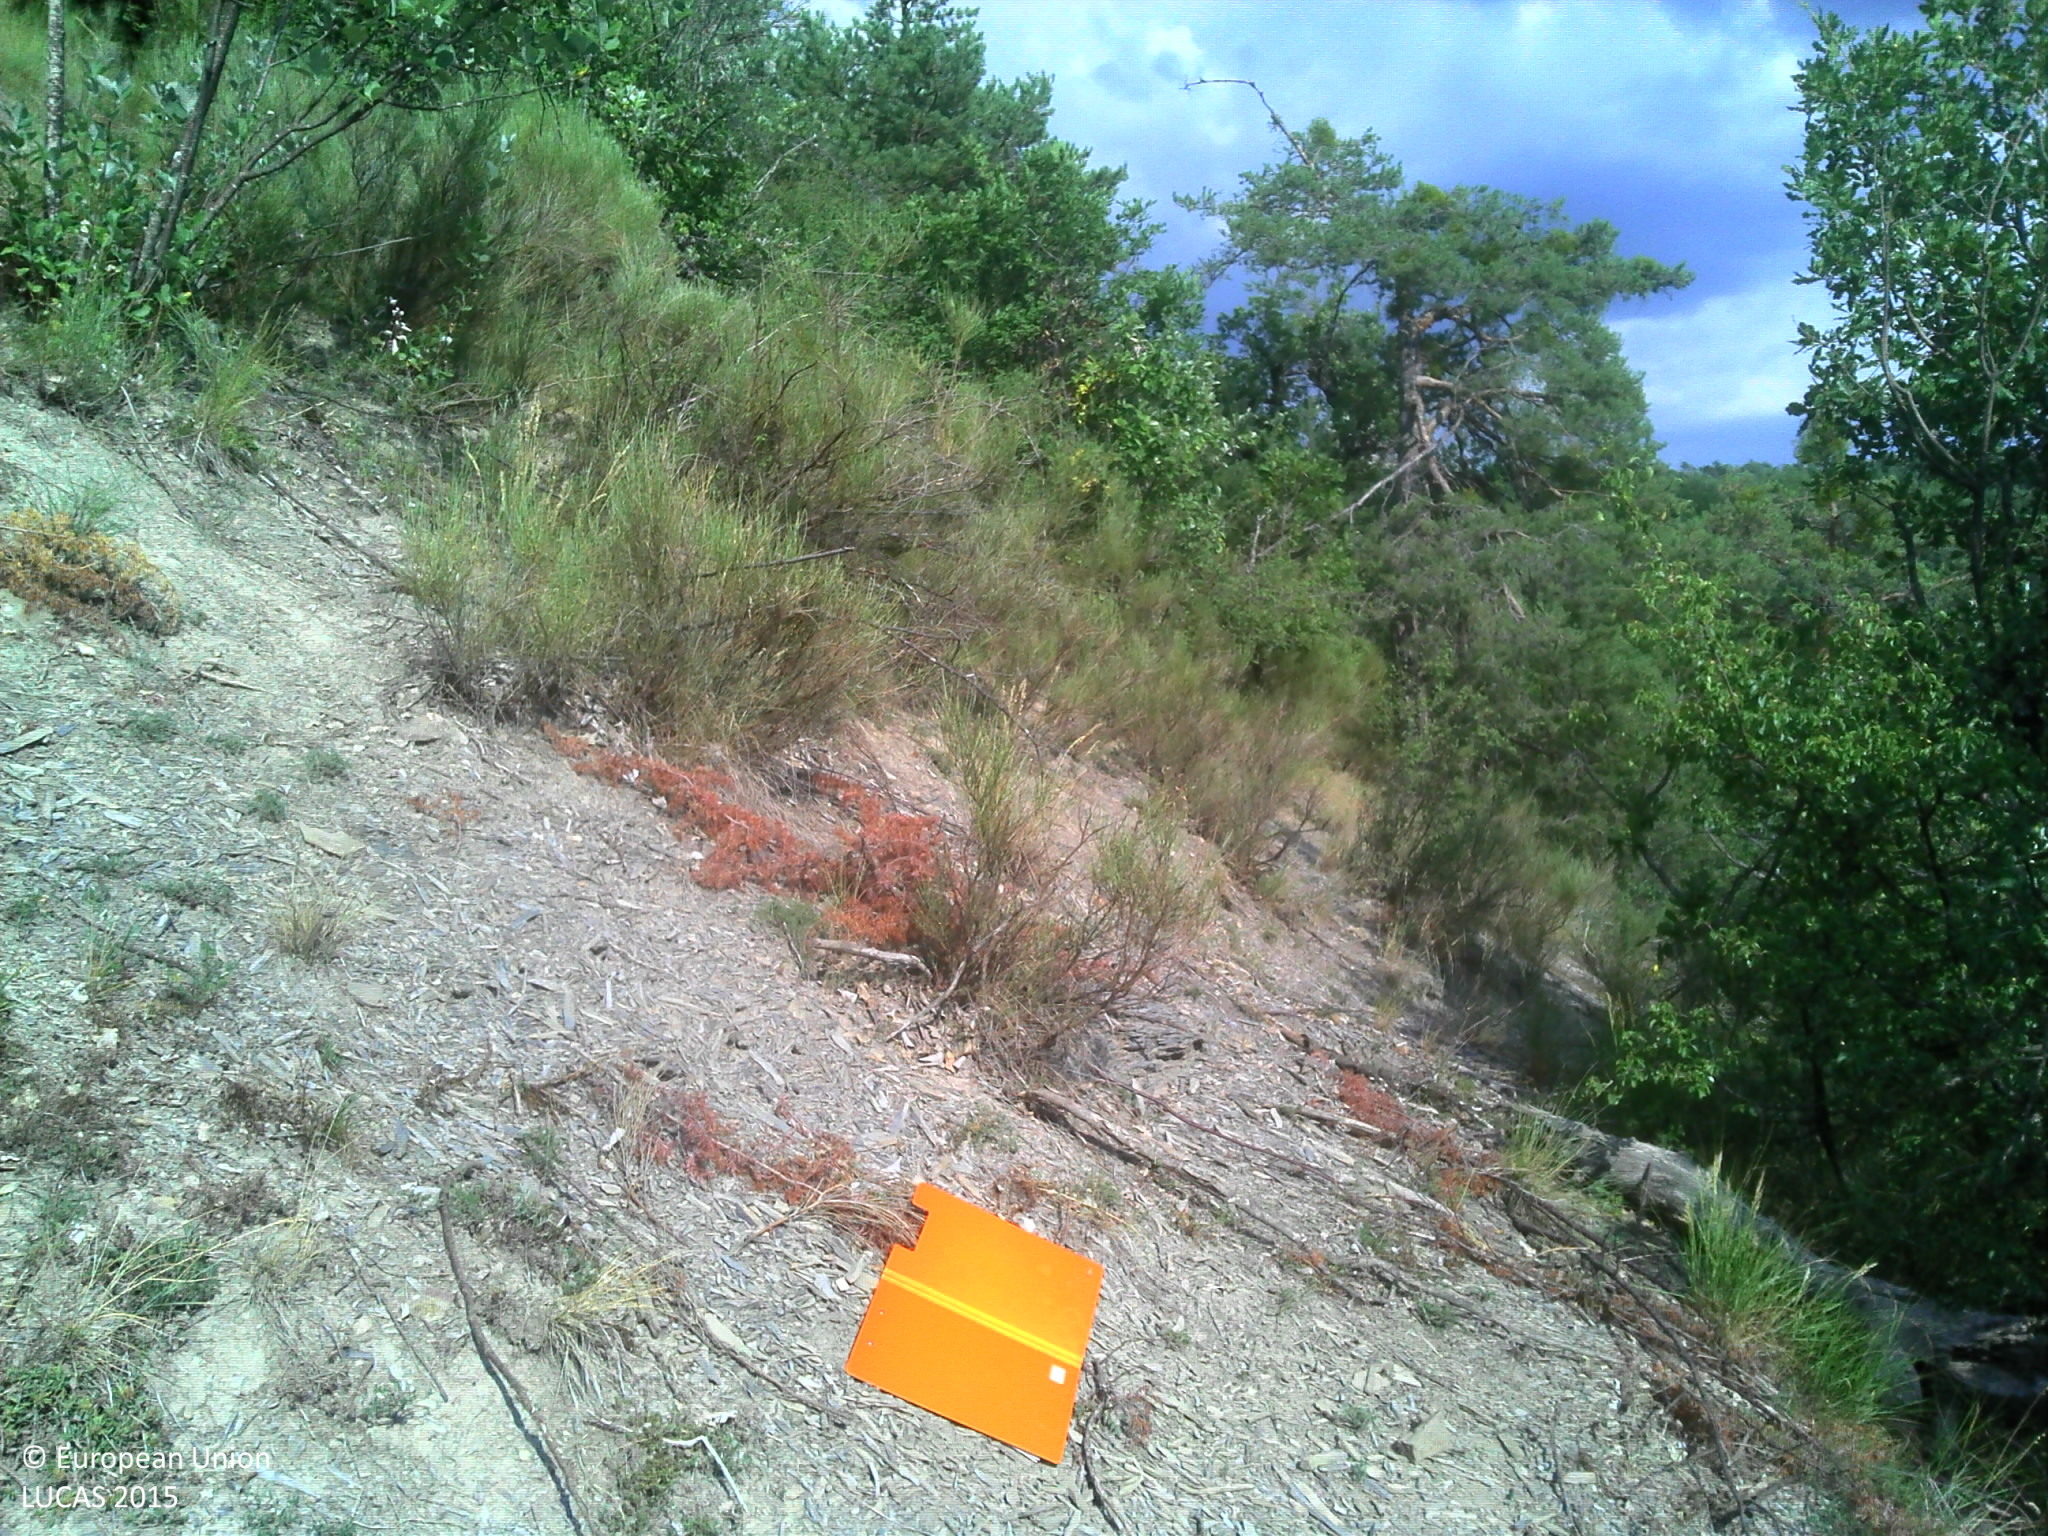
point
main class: Shrubland
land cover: Shrubland with sparse tree cover
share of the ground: 50 - 75 %
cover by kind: shrubs 50 %, herbaceous plants 20 %, consolidated bare surface 15 %, unconsolidated bare surface 10 %, broadleaved forest trees 5 %
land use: Semi-natural and natural areas not in use
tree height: < 5 m
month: August
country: FR
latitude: 44.3922
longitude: 6.2783
